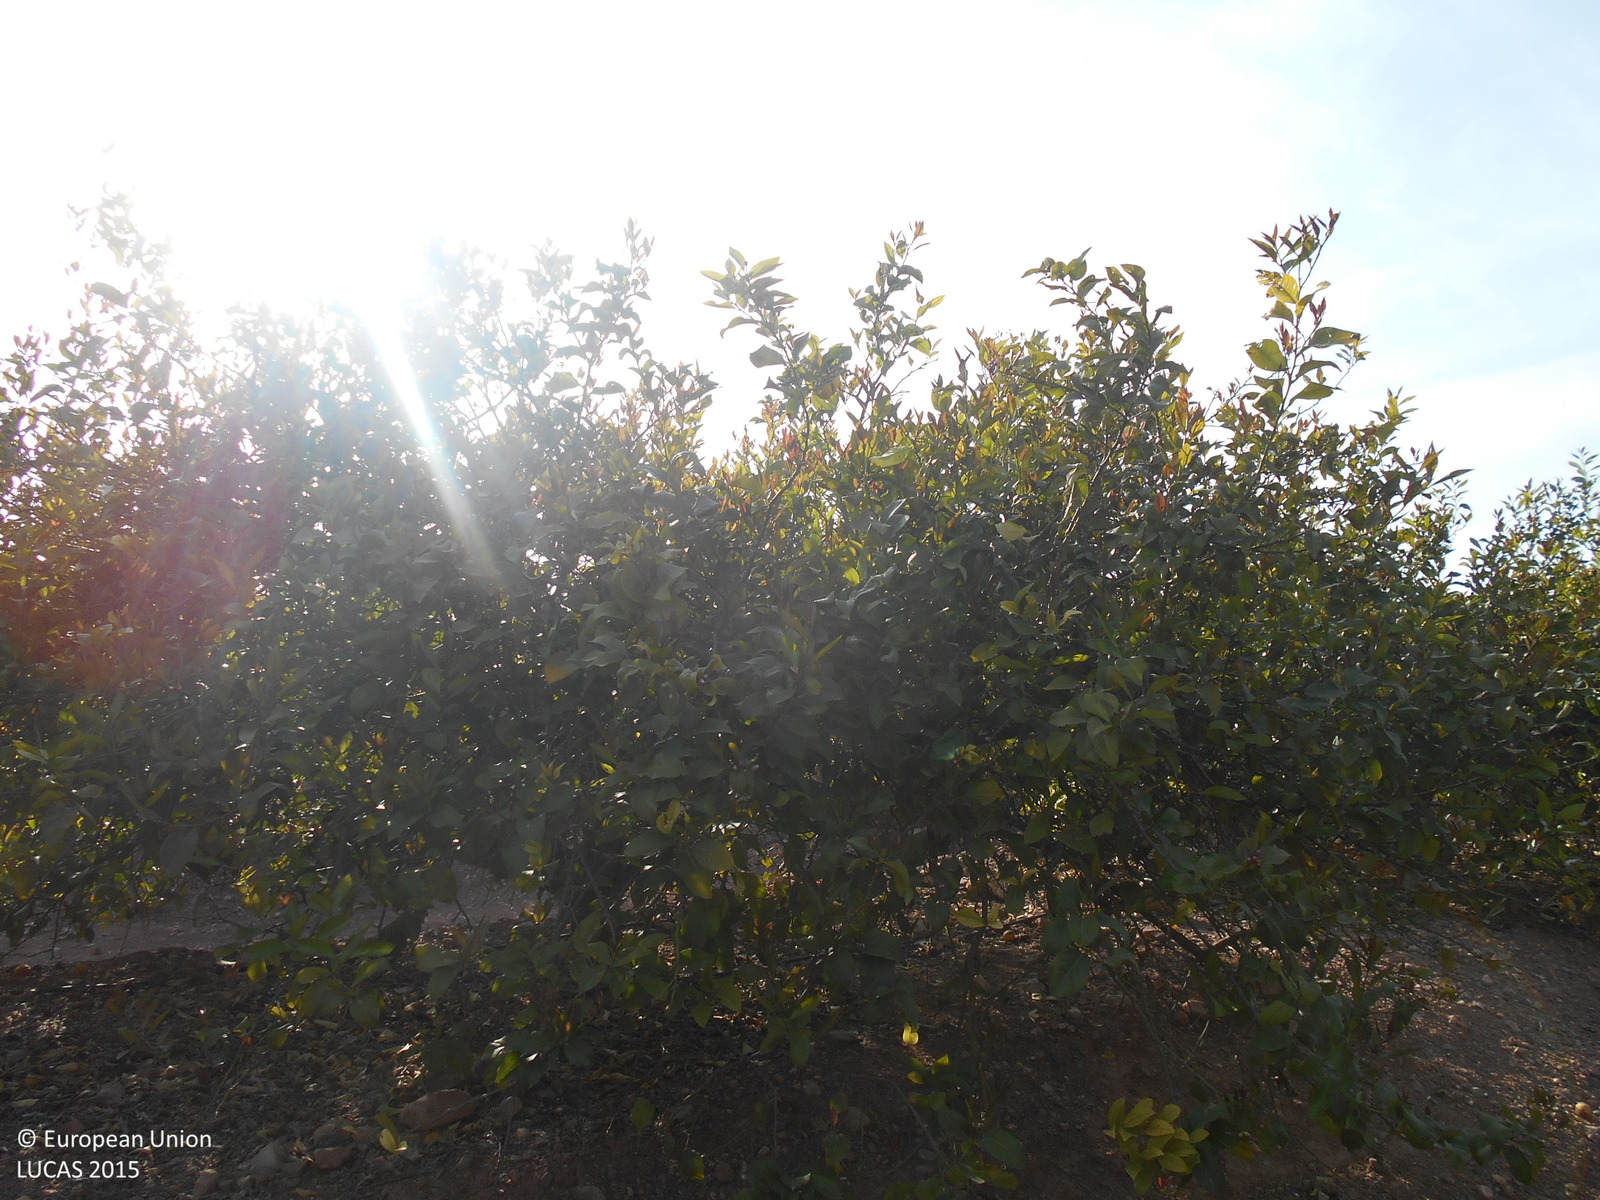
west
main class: Cropland
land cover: Other citrus fruit
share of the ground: > 75 %
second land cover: Other bare soil
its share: > 75 %
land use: Agriculture (excluding fallow land and kitchen gardens)
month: April
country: ES
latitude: 37.7964
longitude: -1.5102
